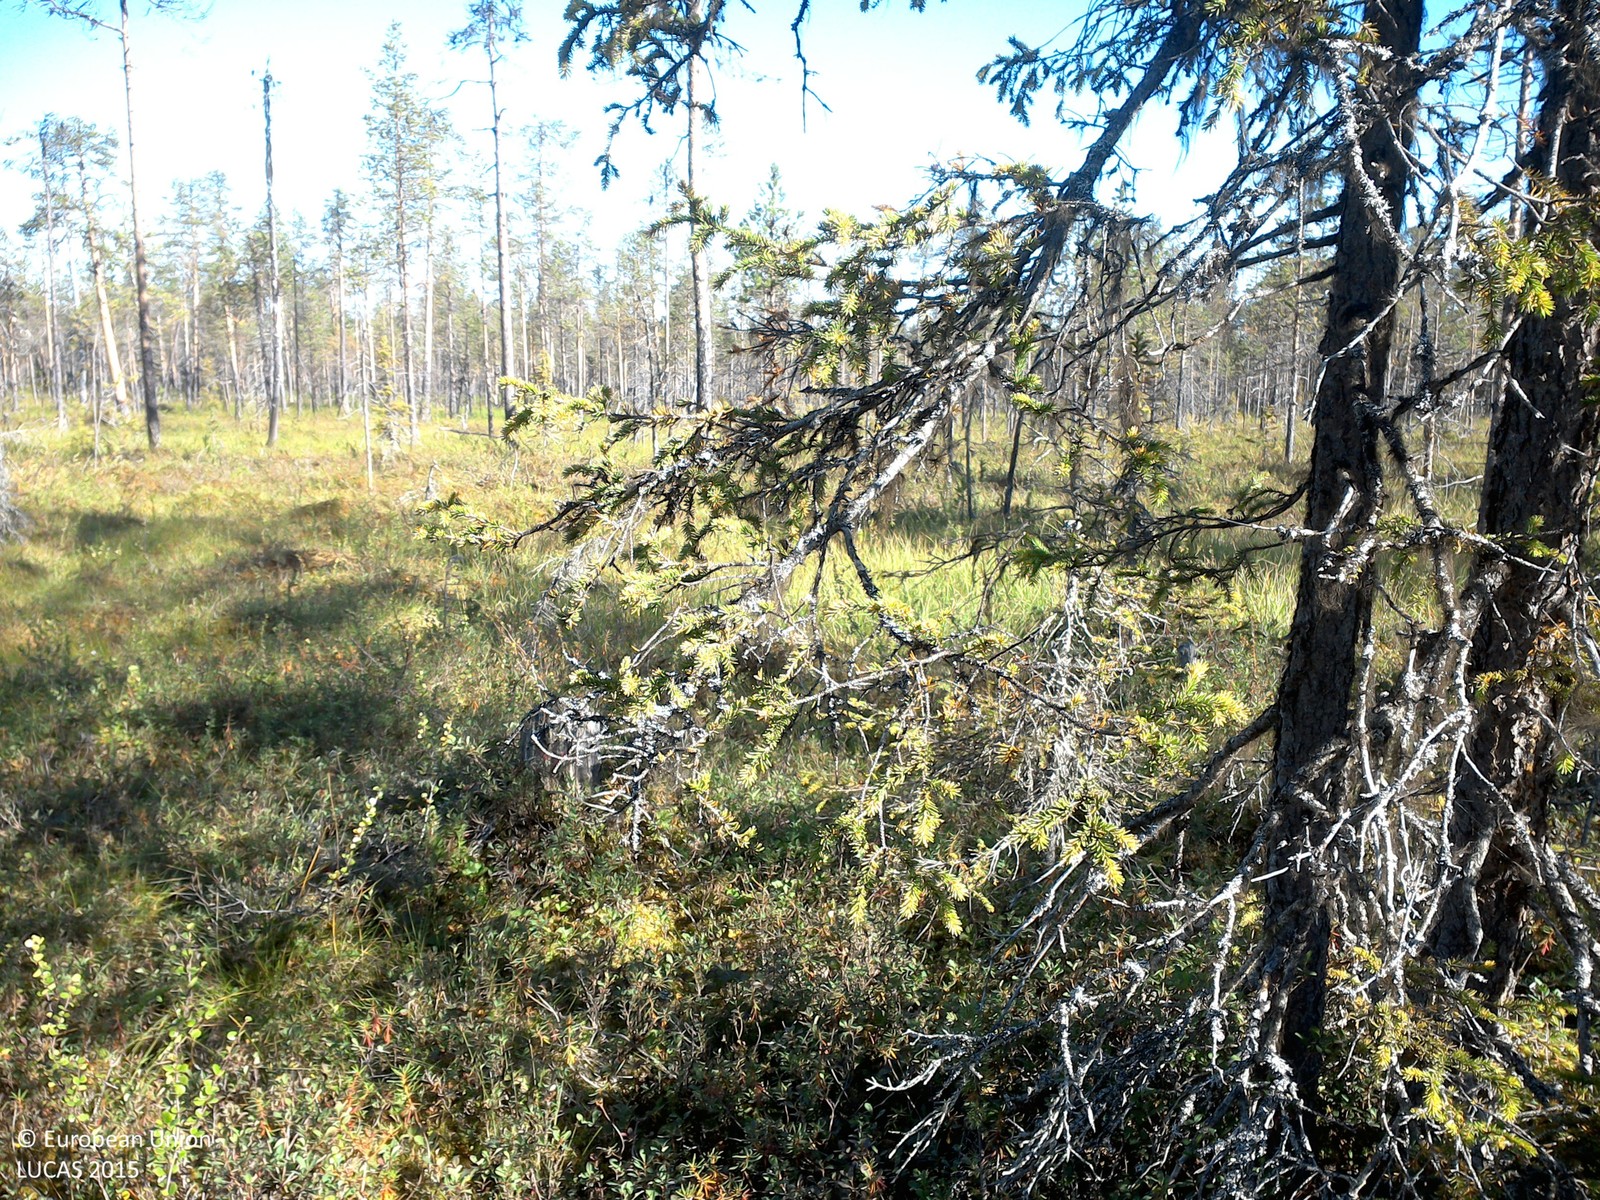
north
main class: Woodland
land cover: Pine dominated coniferous woodland
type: boreal forest
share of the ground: 25 - 50 %
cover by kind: shrubs 65 %, coniferous forest trees 20 %, broadleaved forest trees 5 %, herbaceous plants 5 %, lichens and mosses 5 %
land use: Semi-natural and natural areas not in use
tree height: > 5 m
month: August
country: SE
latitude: 67.2239
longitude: 21.4574
